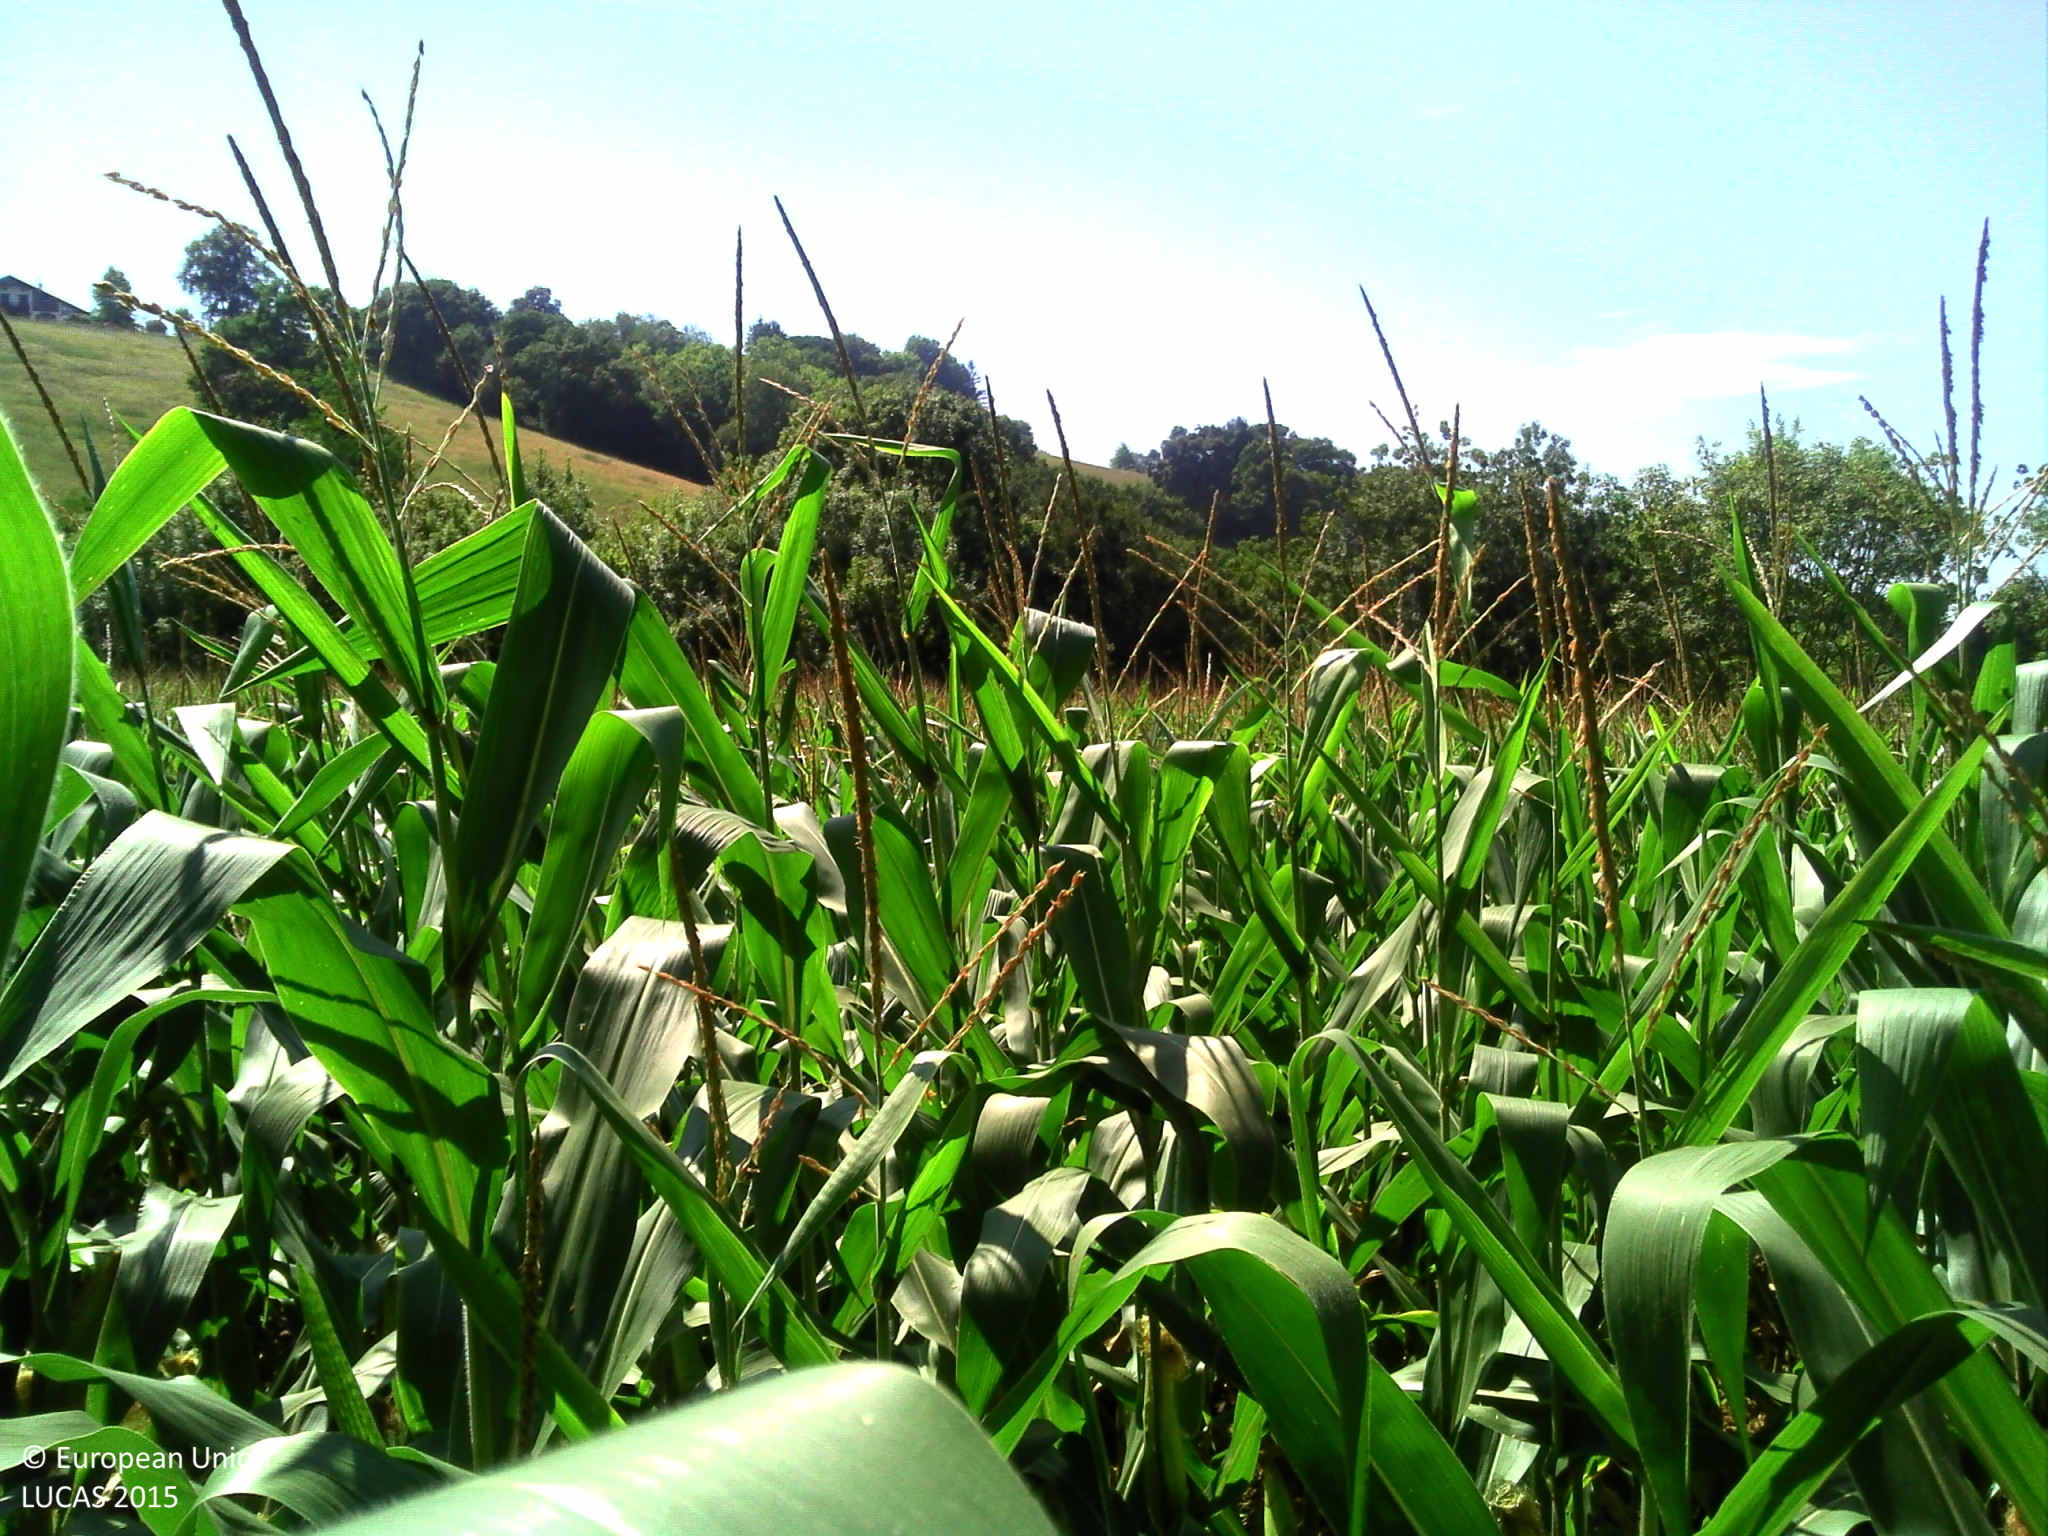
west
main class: Cropland
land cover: Maize
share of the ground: > 75 %
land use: Agriculture (excluding fallow land and kitchen gardens)
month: August
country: FR
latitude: 43.3220
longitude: -1.0493
